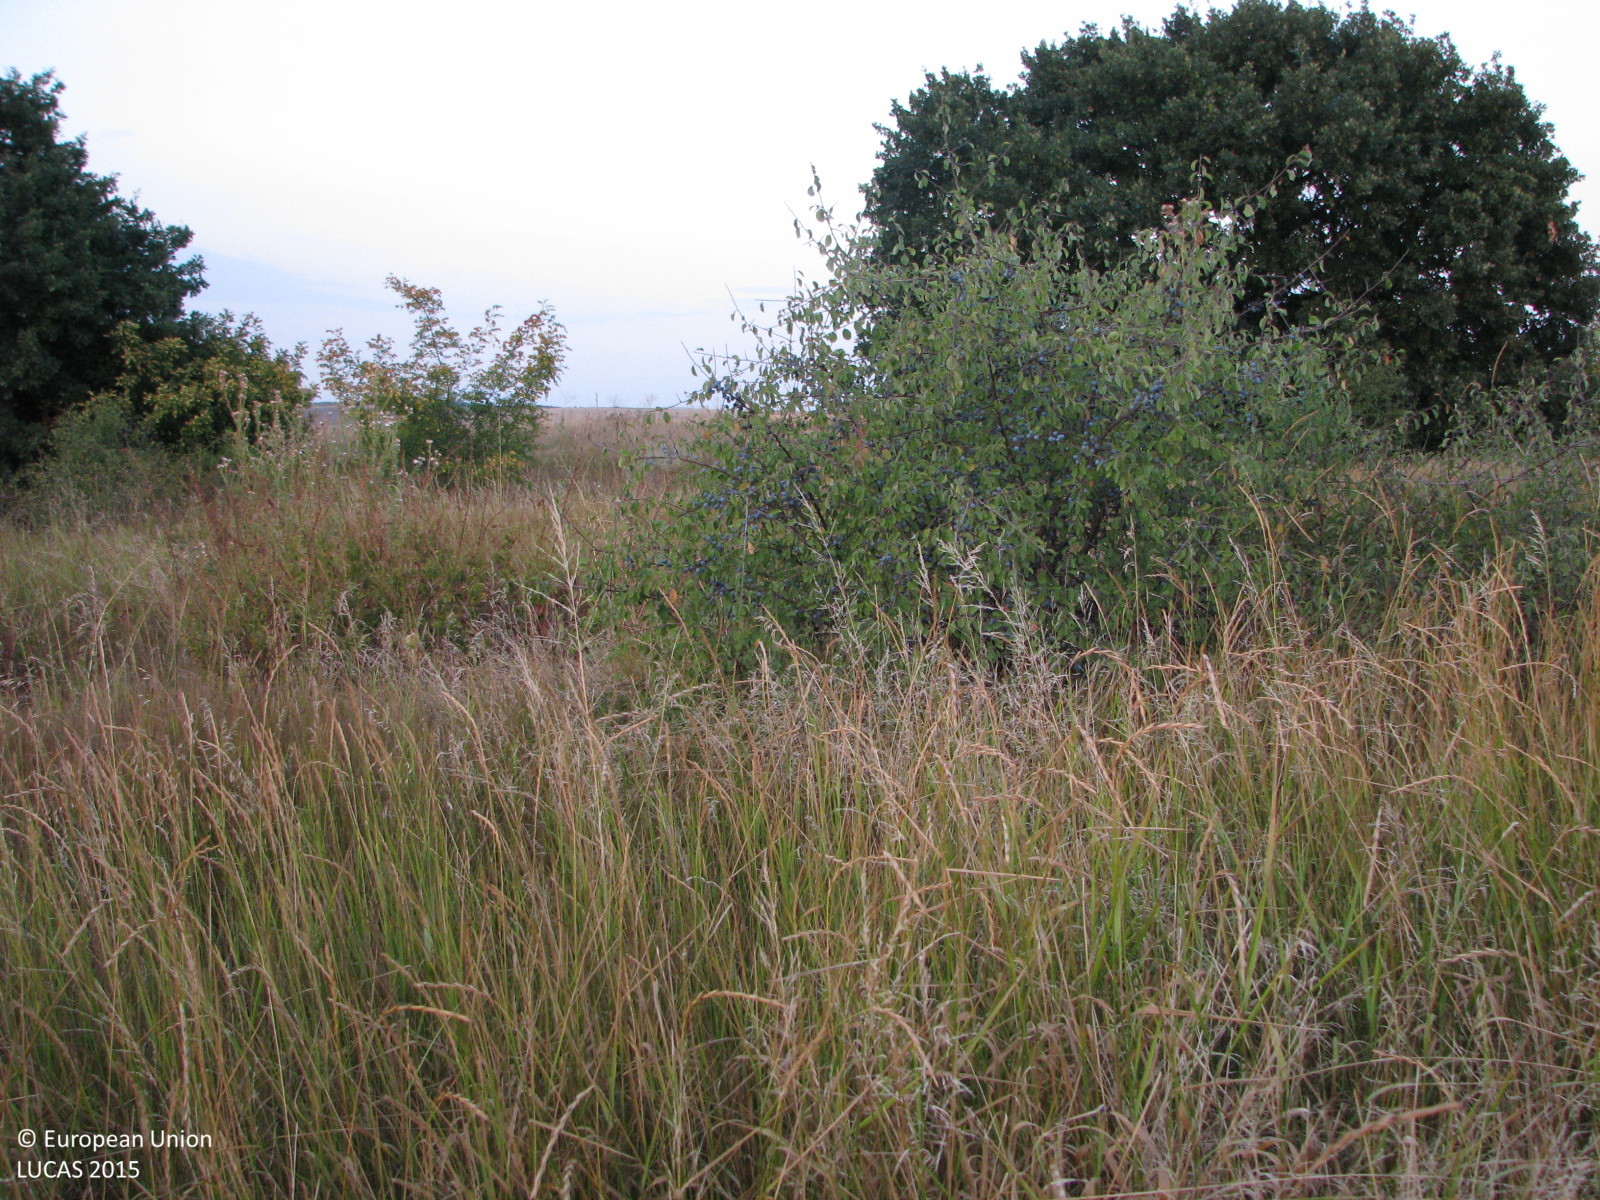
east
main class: Grassland
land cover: Grassland with sparse tree/shrub cover
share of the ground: > 75 %
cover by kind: herbaceous plants 90 %, broadleaved forest trees 5 %, shrubs 5 %
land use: Semi-natural and natural areas not in use
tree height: > 5 m
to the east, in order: Grassland with sparse tree/shrub cover; Other non-permanent industrial crops
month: August
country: BG
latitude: 42.4786
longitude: 26.6514
